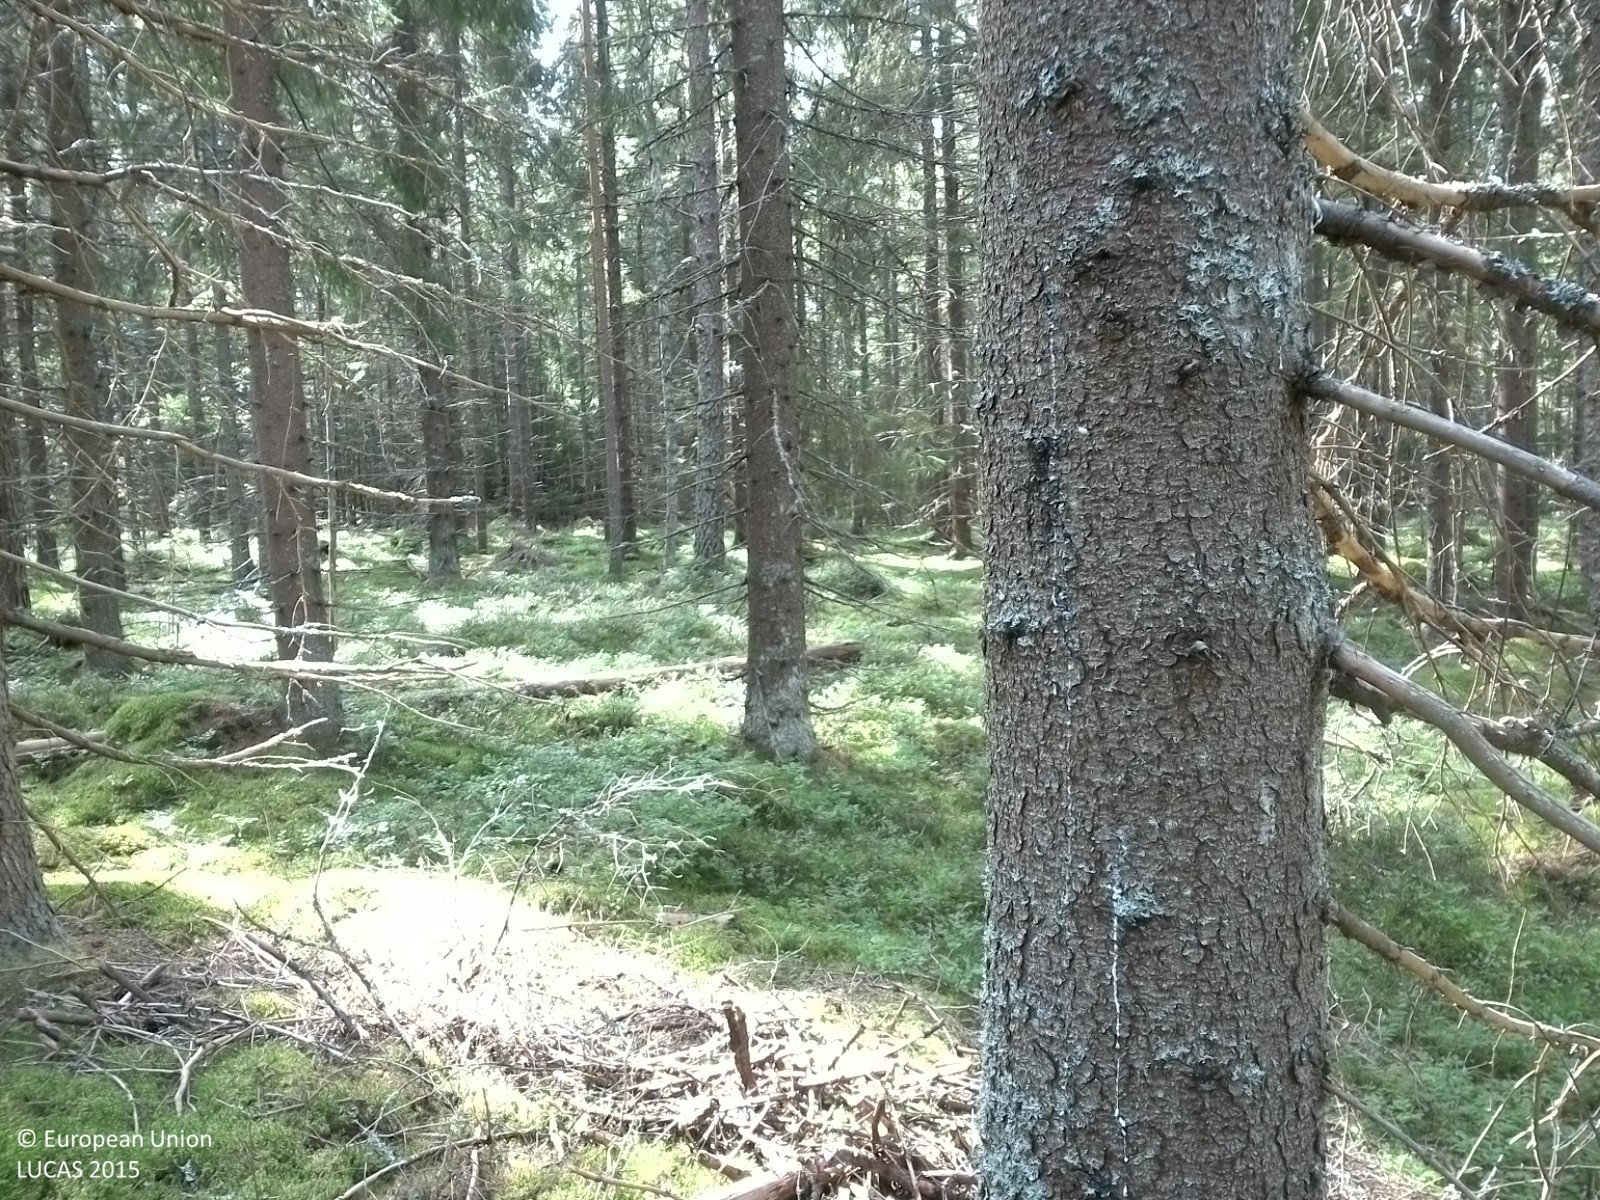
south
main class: Woodland
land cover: Spruce dominated coniferous woodland
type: boreal forest
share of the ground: 50 - 75 %
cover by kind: coniferous forest trees 60 %, lichens and mosses 30 %, herbaceous plants 10 %
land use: Forestry
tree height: > 5 m
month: August
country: SE
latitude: 59.0536
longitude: 14.7866
